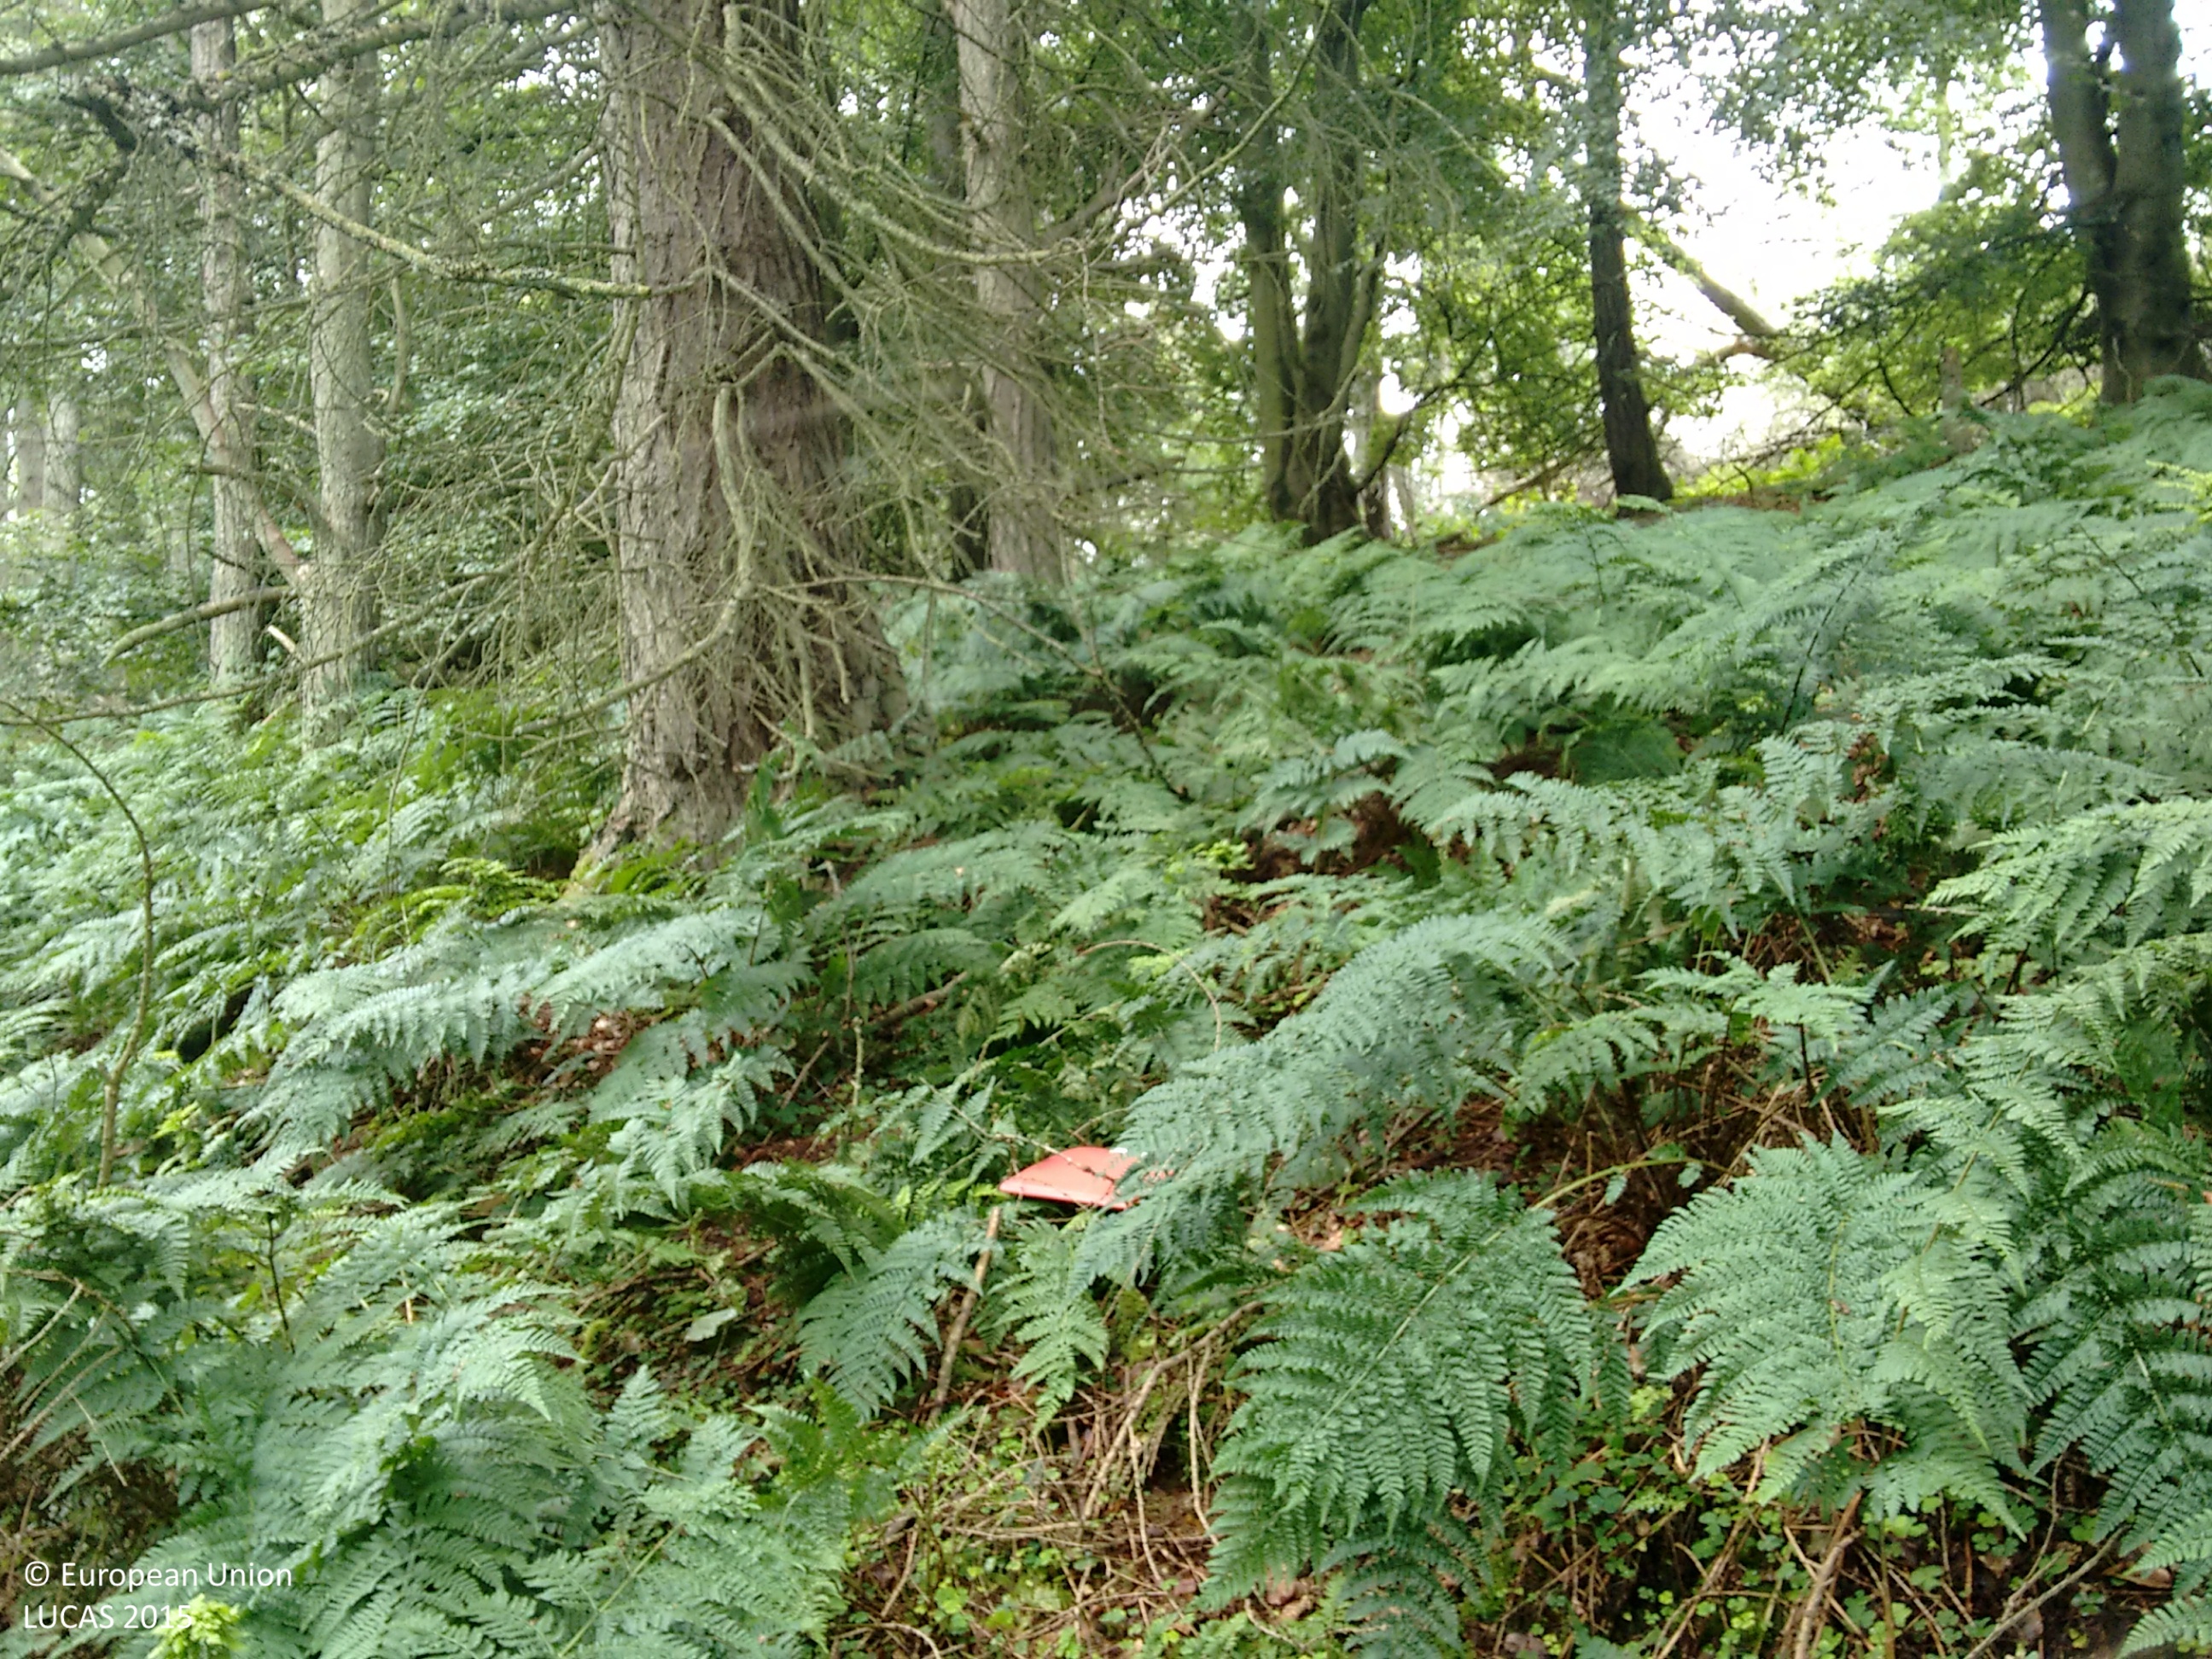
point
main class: Woodland
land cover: Other mixed woodland
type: acidophilous oak and oak-birch forest
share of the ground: > 75 %
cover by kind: coniferous forest trees 60 %, broadleaved forest trees 35 %, herbaceous plants 5 %
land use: Forestry
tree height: > 5 m
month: July
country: GB
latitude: 56.3860
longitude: -2.9416
